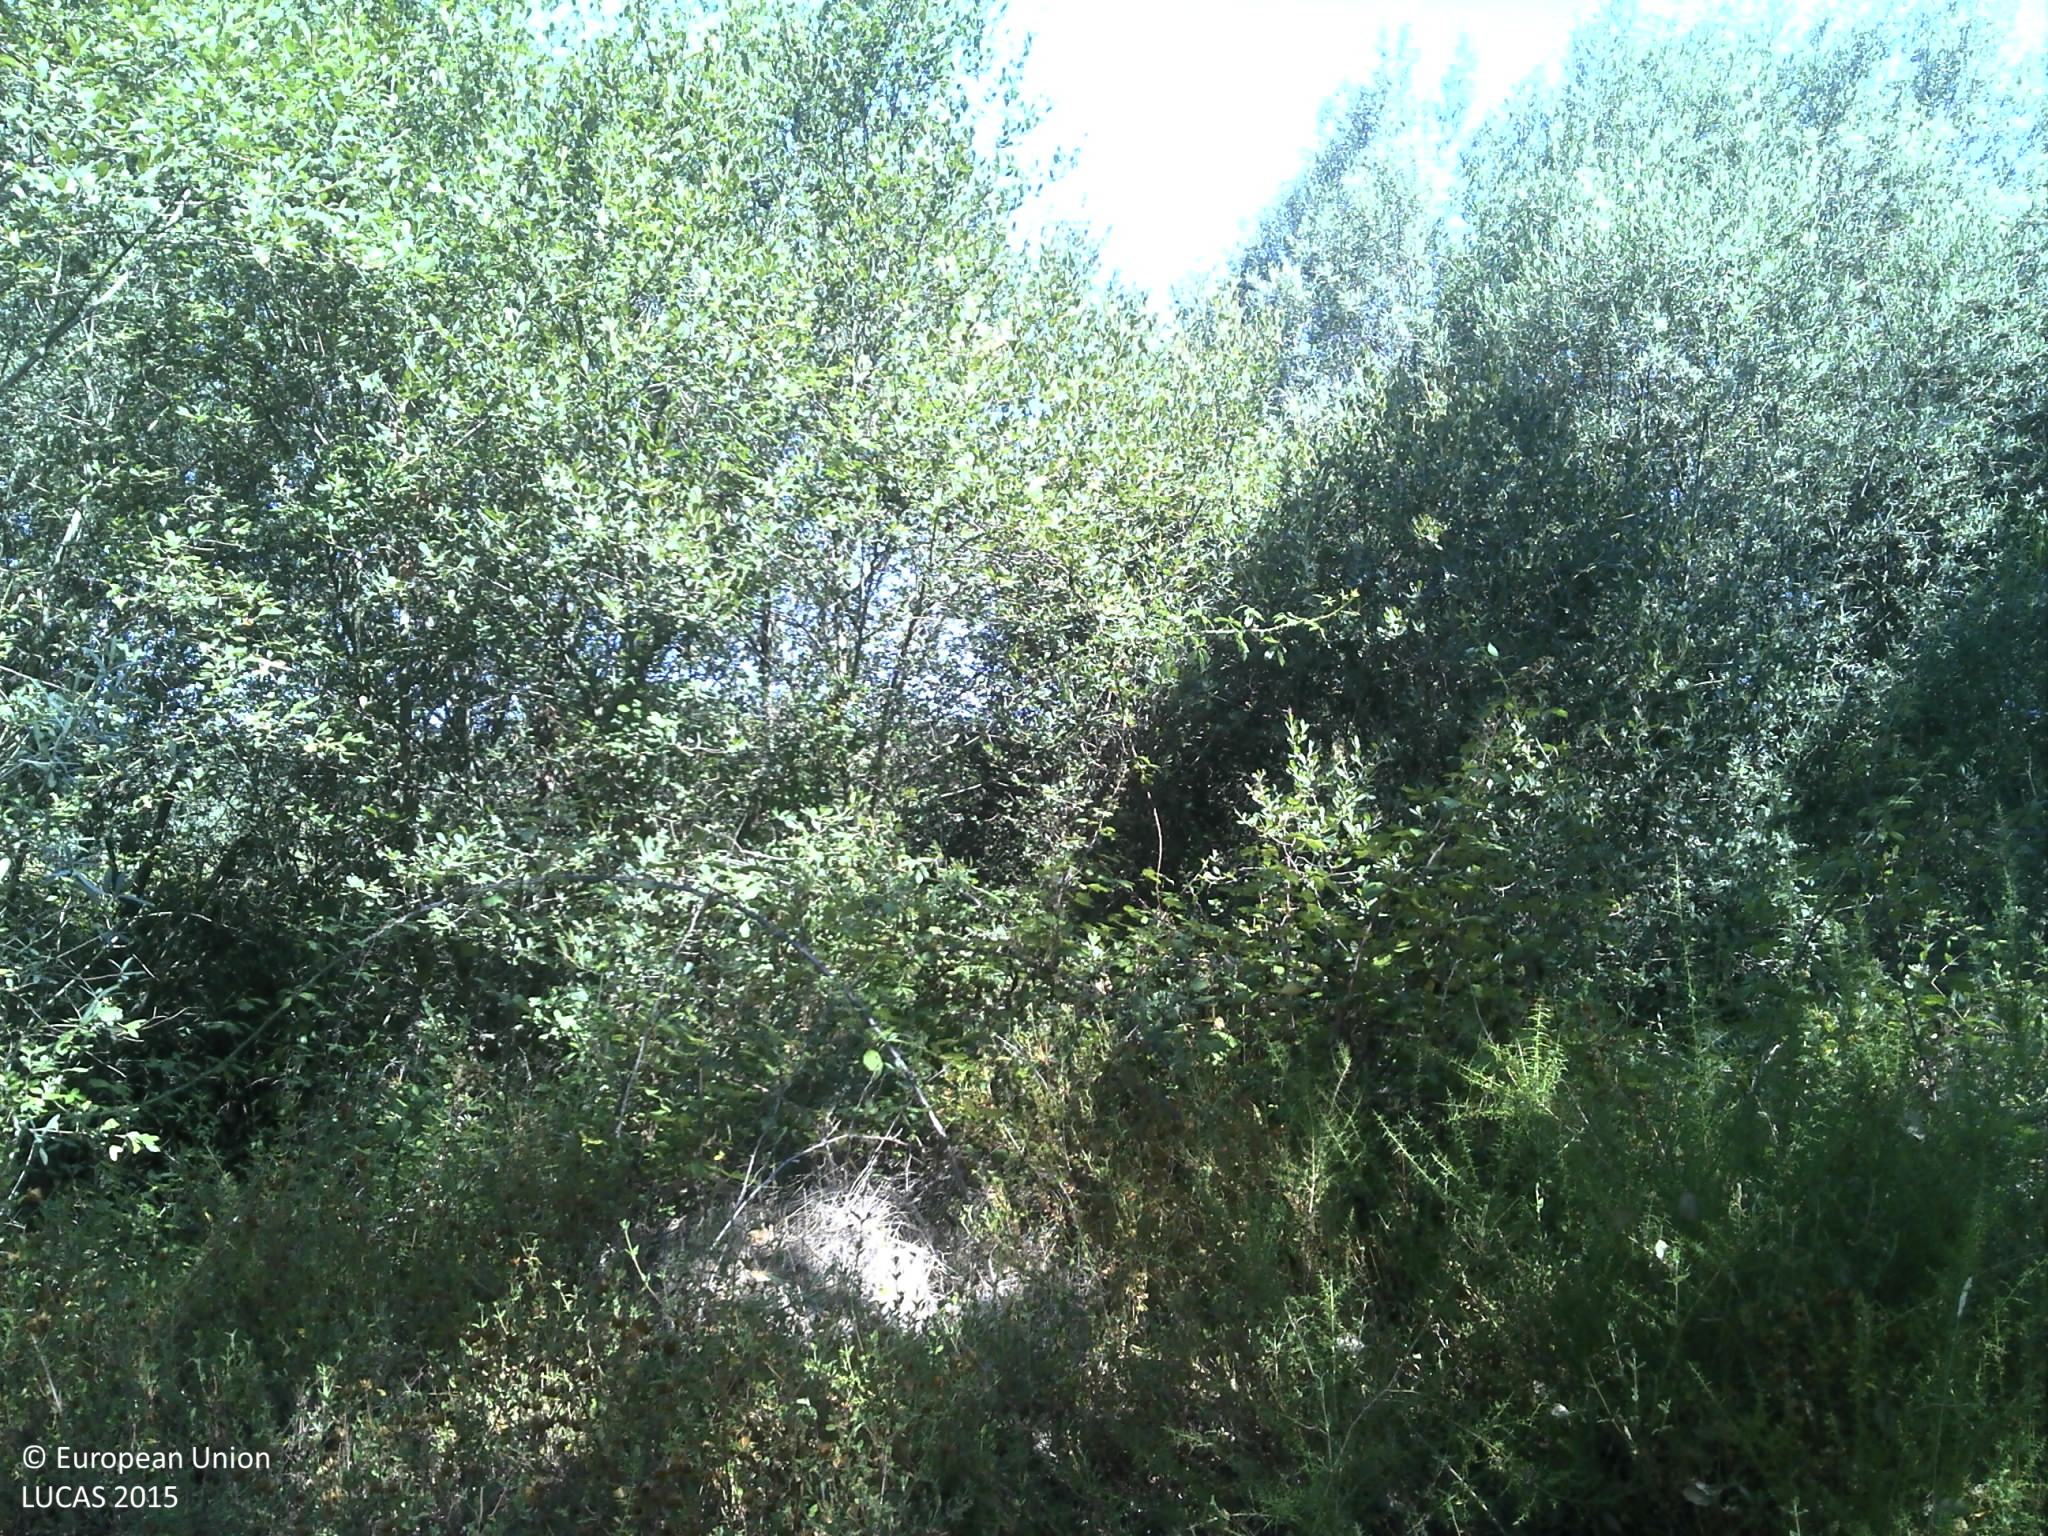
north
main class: Woodland
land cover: Broadleaved woodland
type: broadleaved evergreen forest
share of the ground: 50 - 75 %
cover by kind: broadleaved forest trees 70 %, unconsolidated bare surface 15 %, herbaceous plants 10 %, shrubs 5 %
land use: Forestry
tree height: > 5 m
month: July
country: PT
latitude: 39.2438
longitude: -8.2400
